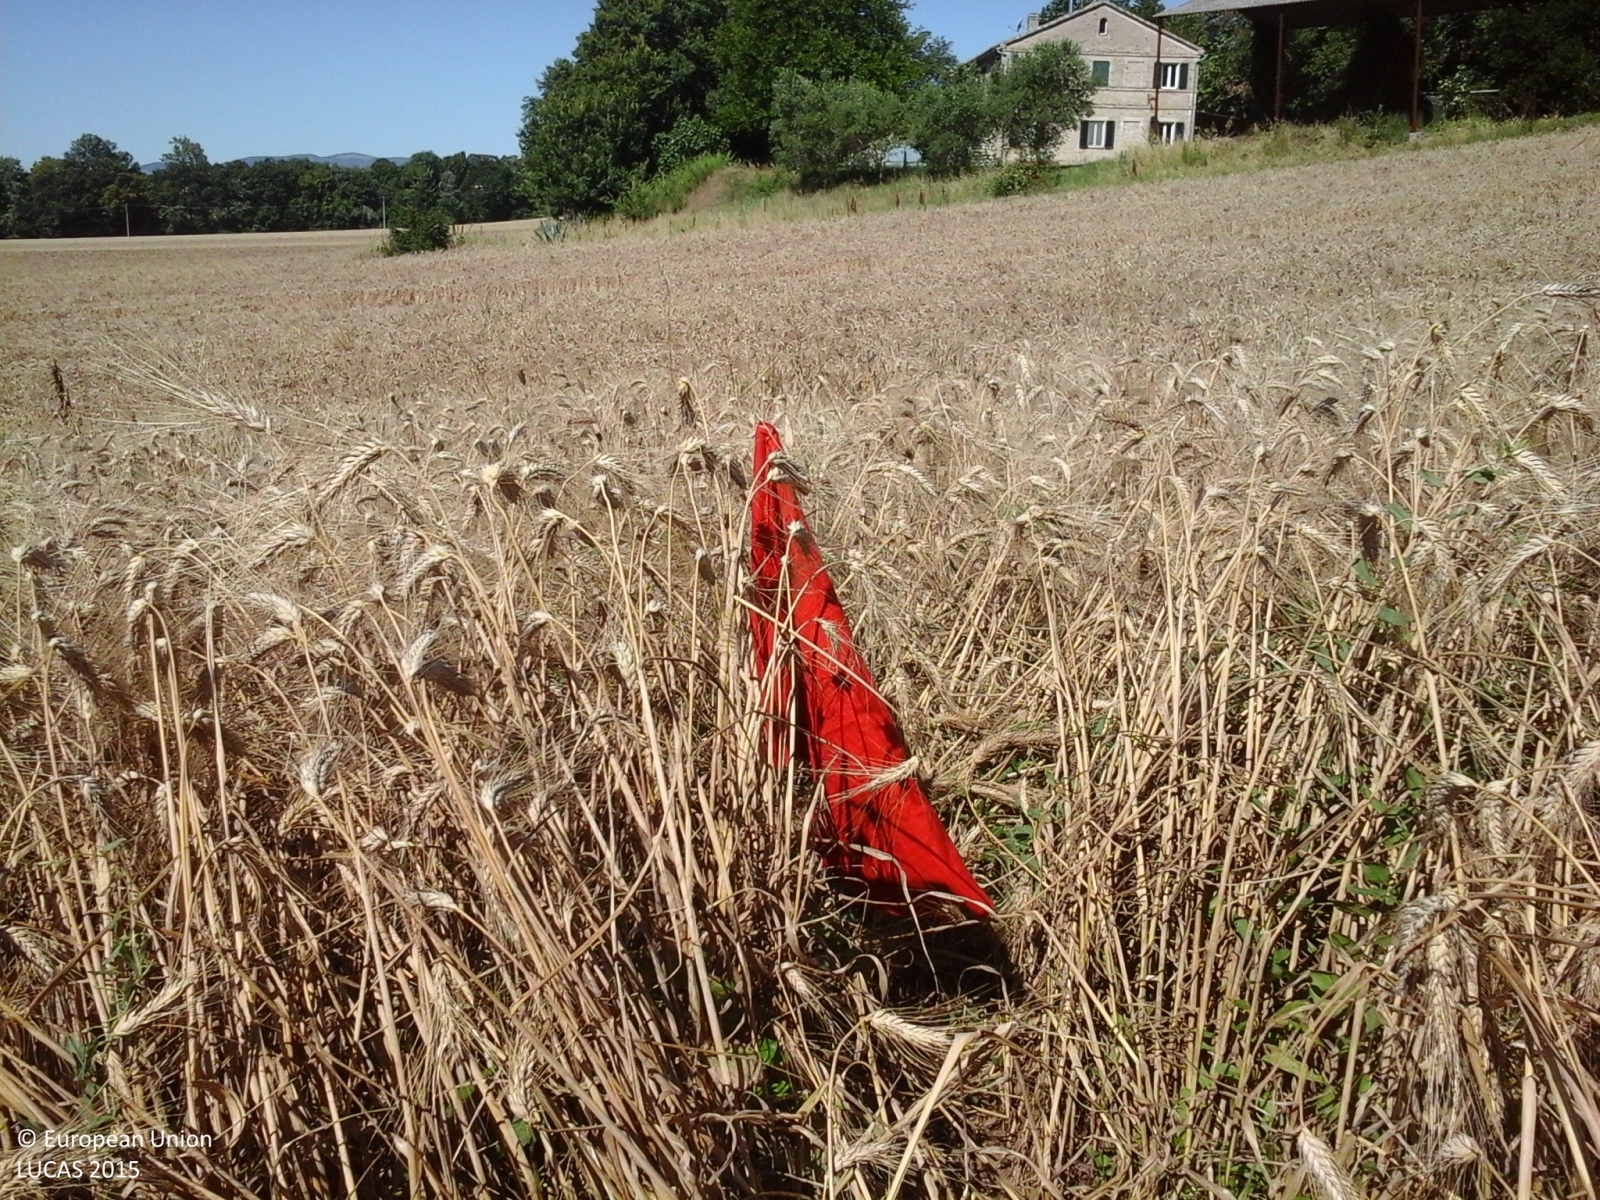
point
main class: Cropland
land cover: Durum wheat
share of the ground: > 75 %
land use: Agriculture (excluding fallow land and kitchen gardens)
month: June
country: IT
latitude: 43.3916
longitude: 13.4111
